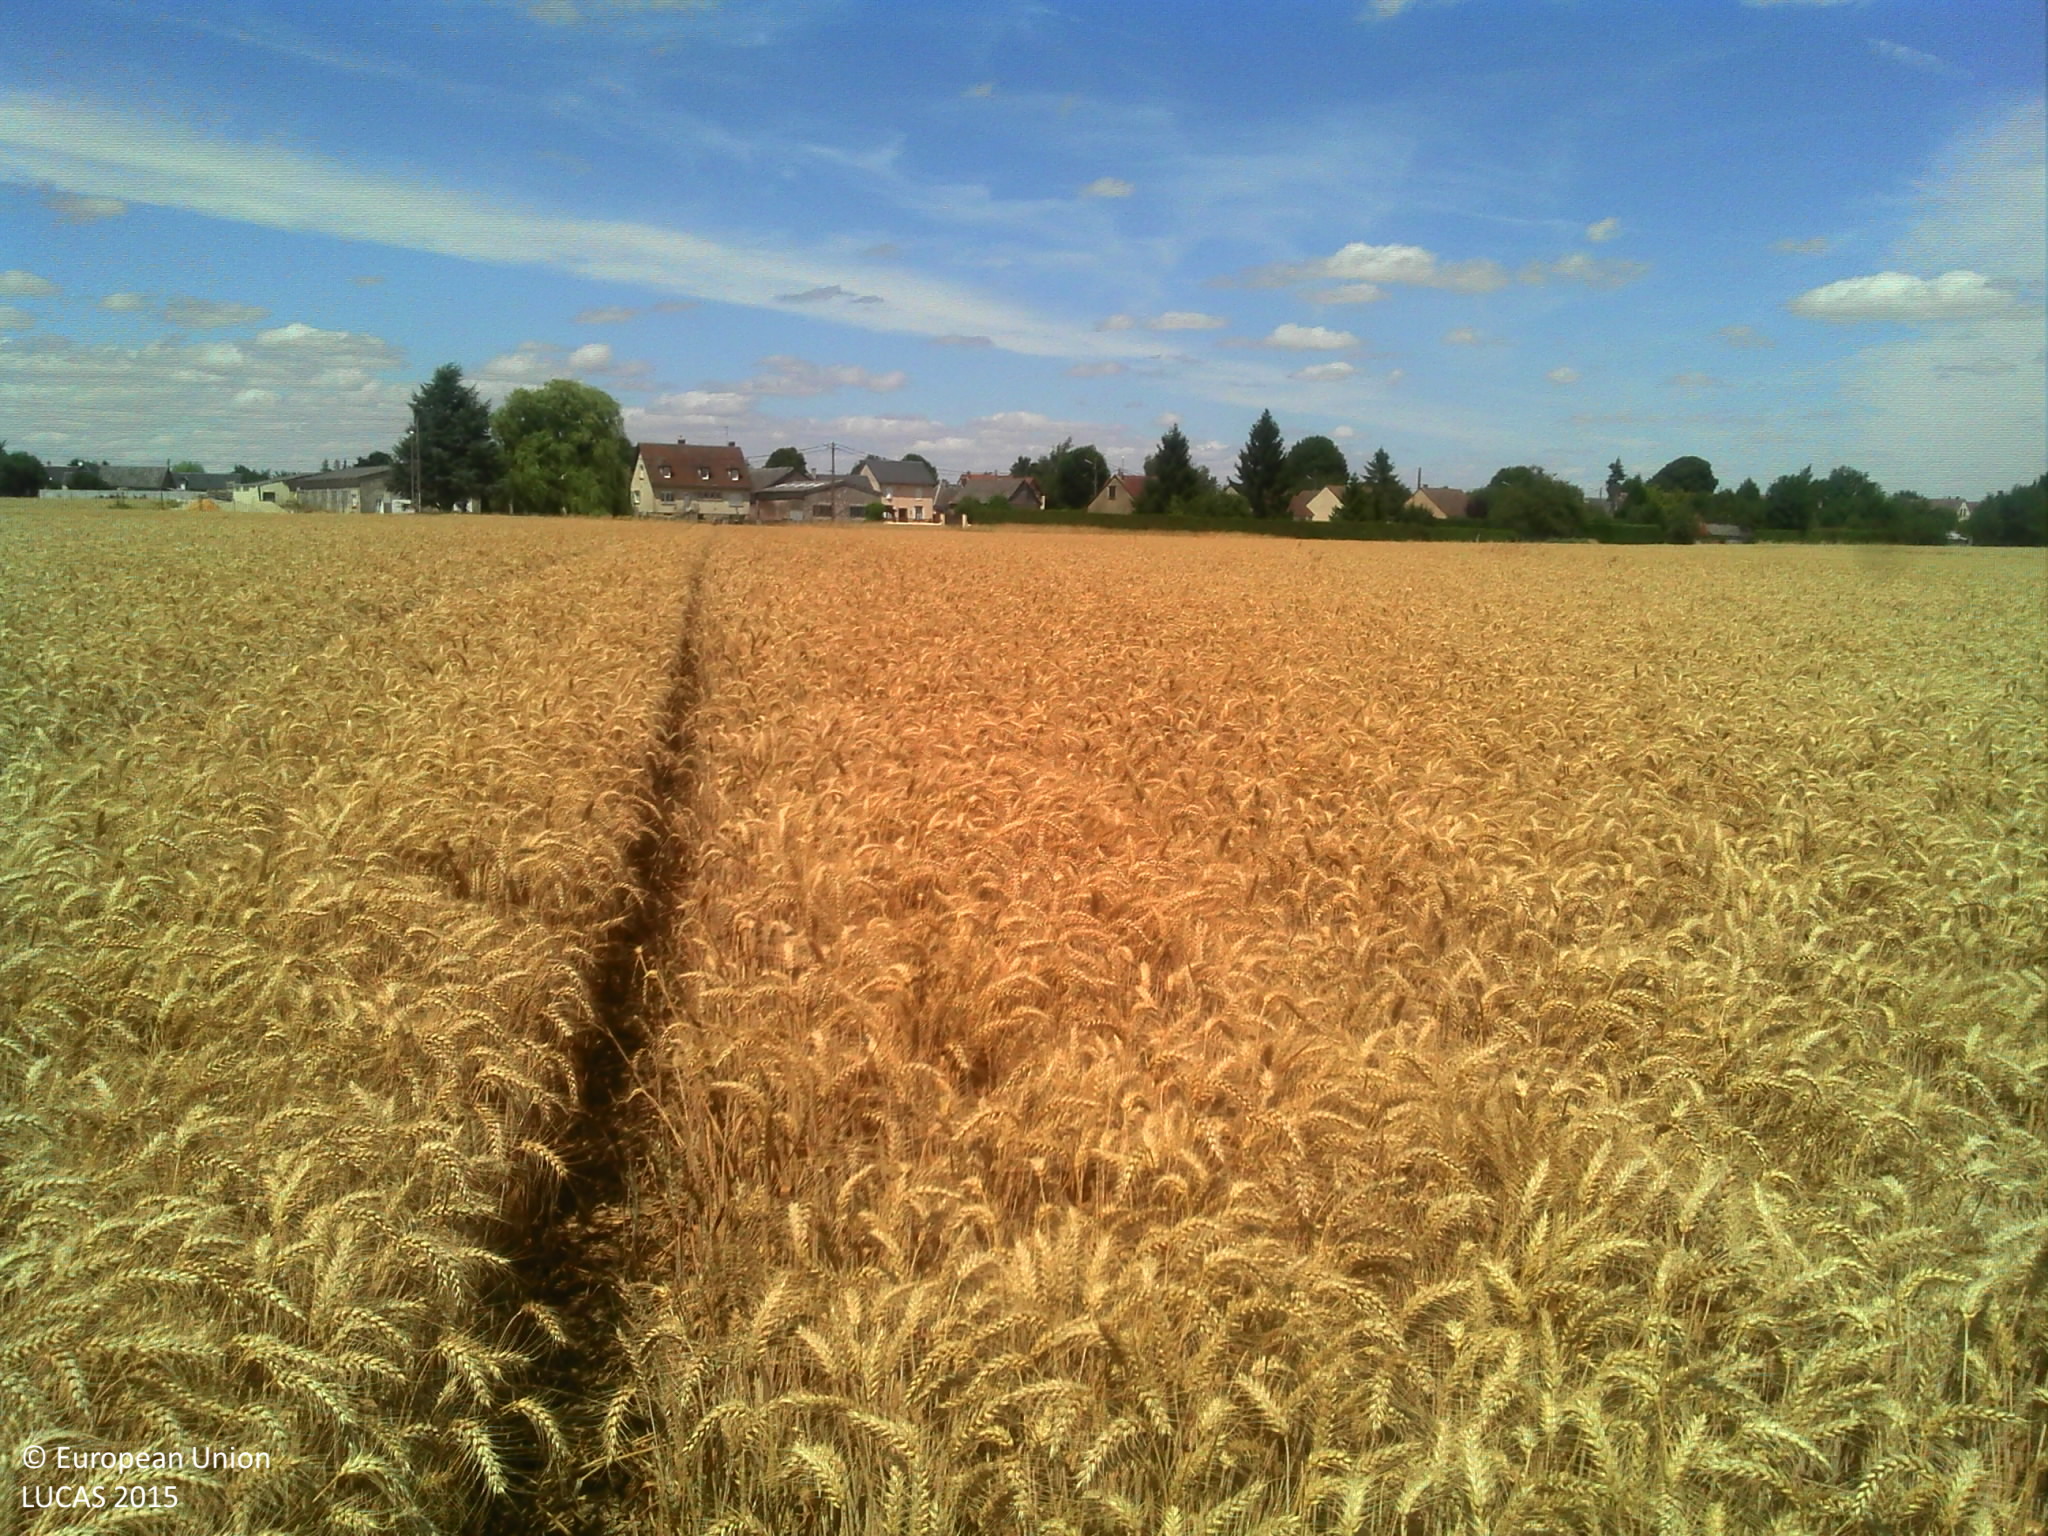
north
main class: Cropland
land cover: Common wheat
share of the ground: > 75 %
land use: Agriculture (excluding fallow land and kitchen gardens)
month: July
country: FR
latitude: 48.3636
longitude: 1.2488
